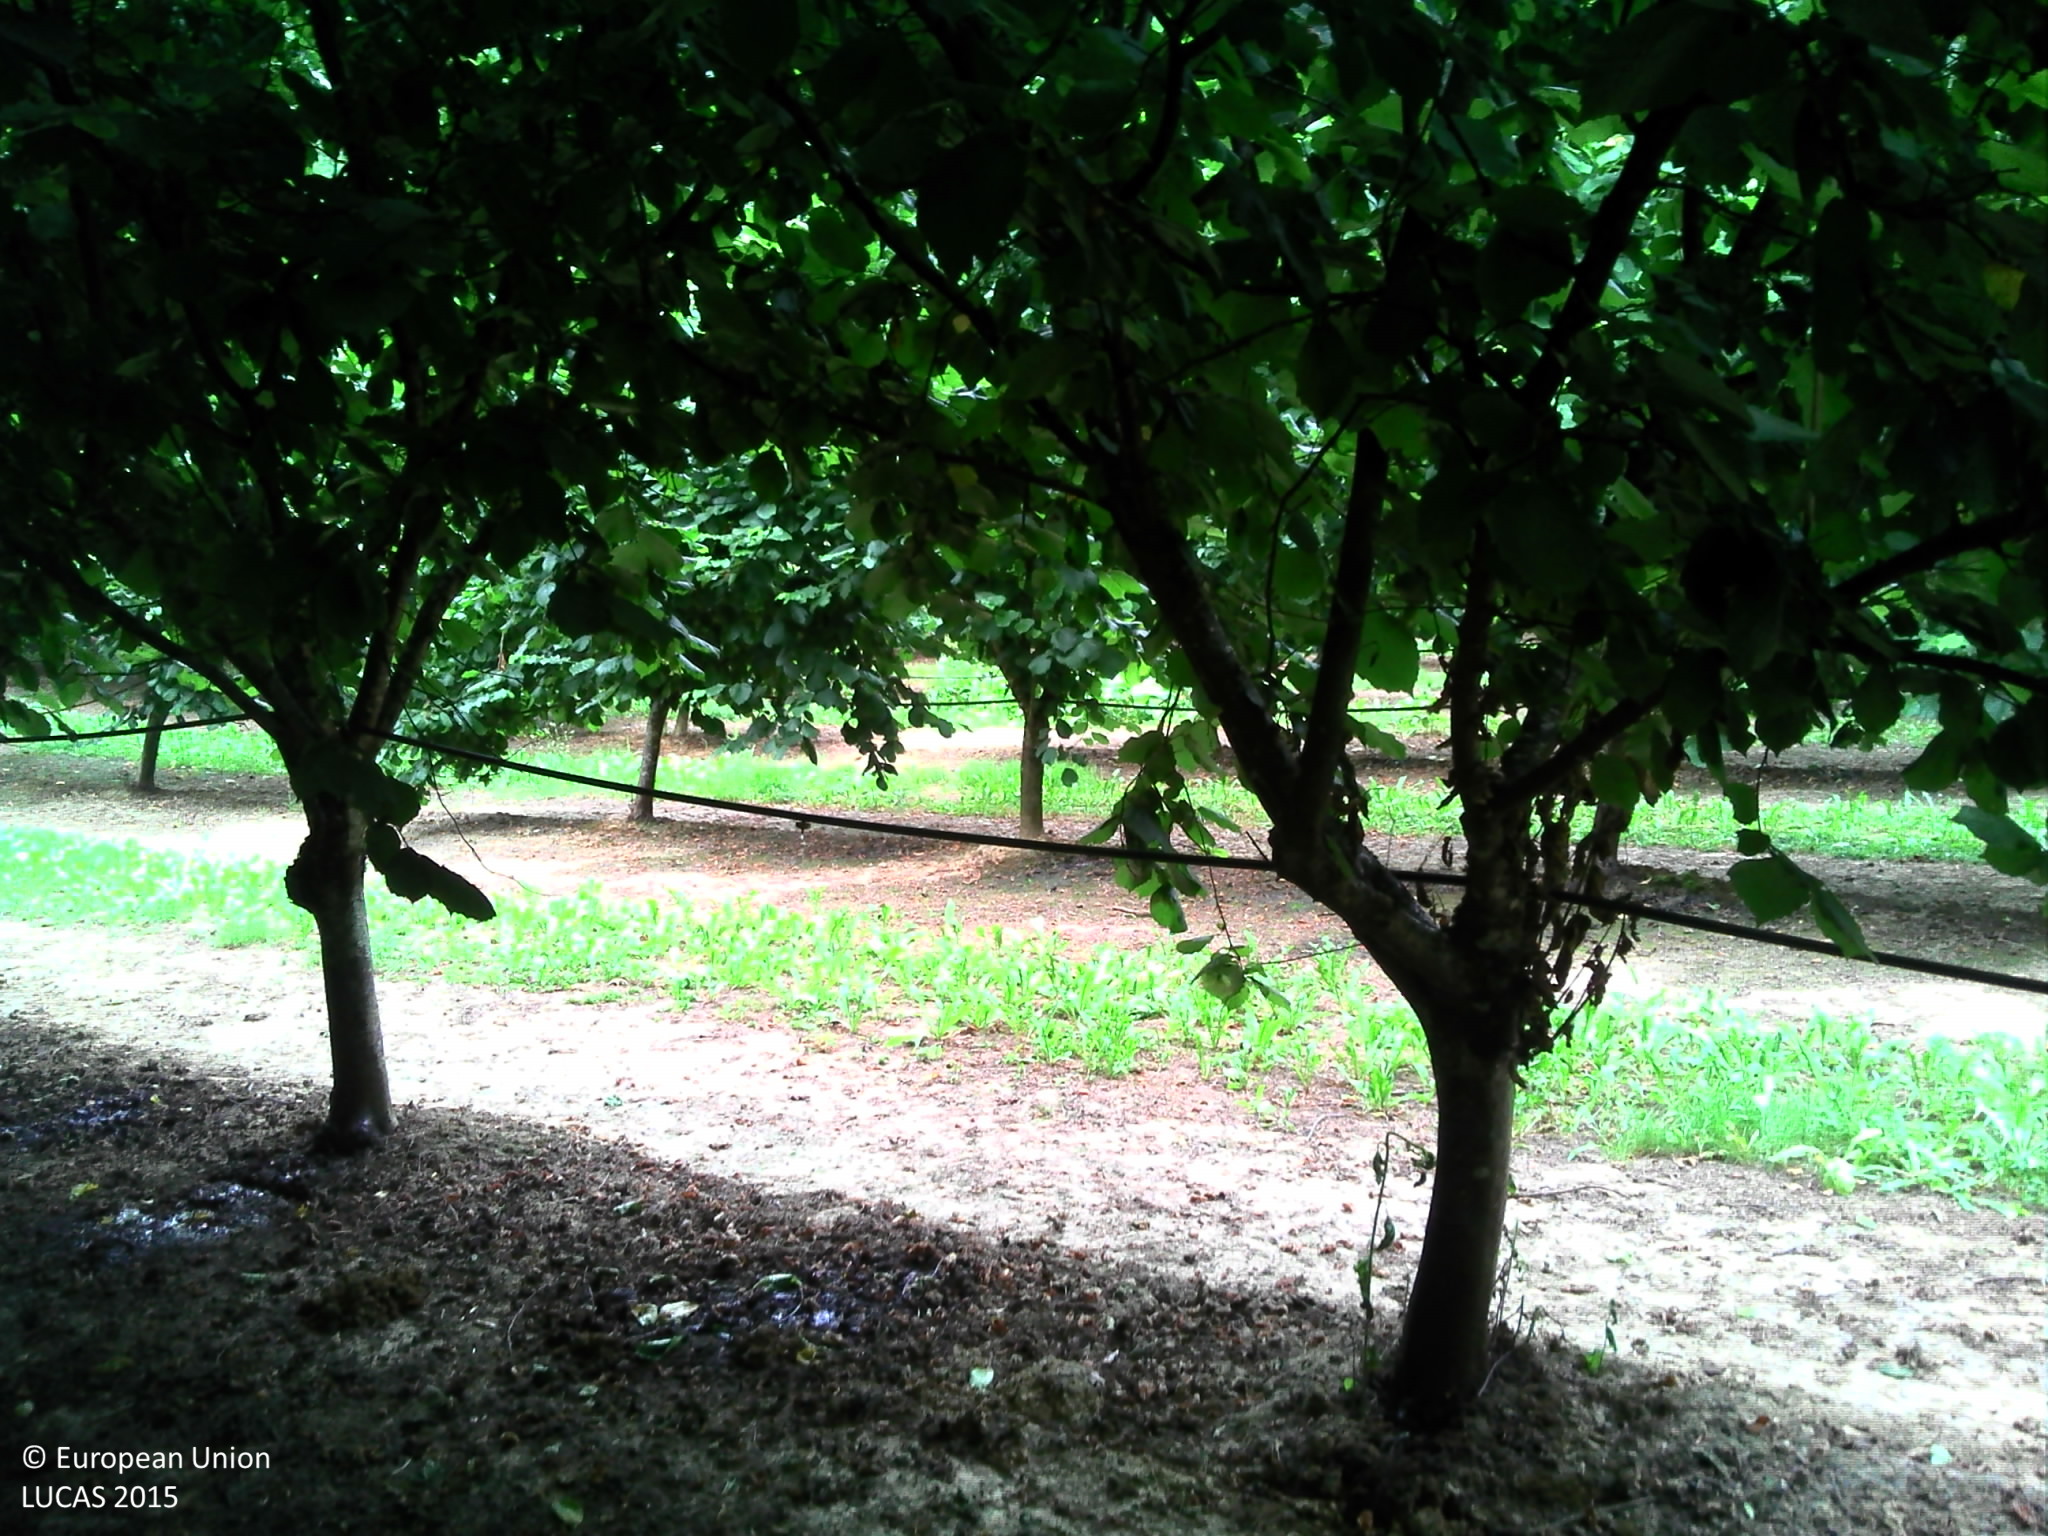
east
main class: Cropland
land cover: Nuts trees
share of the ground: > 75 %
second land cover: Spontaneously vegetated surfaces
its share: < 10 %
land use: Agriculture (excluding fallow land and kitchen gardens)
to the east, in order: Nuts trees; Spontaneously vegetated surfaces; Other bare soil; Broadleaved woodland; Grassland without tree/shrub cover
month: July
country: FR
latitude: 44.4699
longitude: 0.8306
